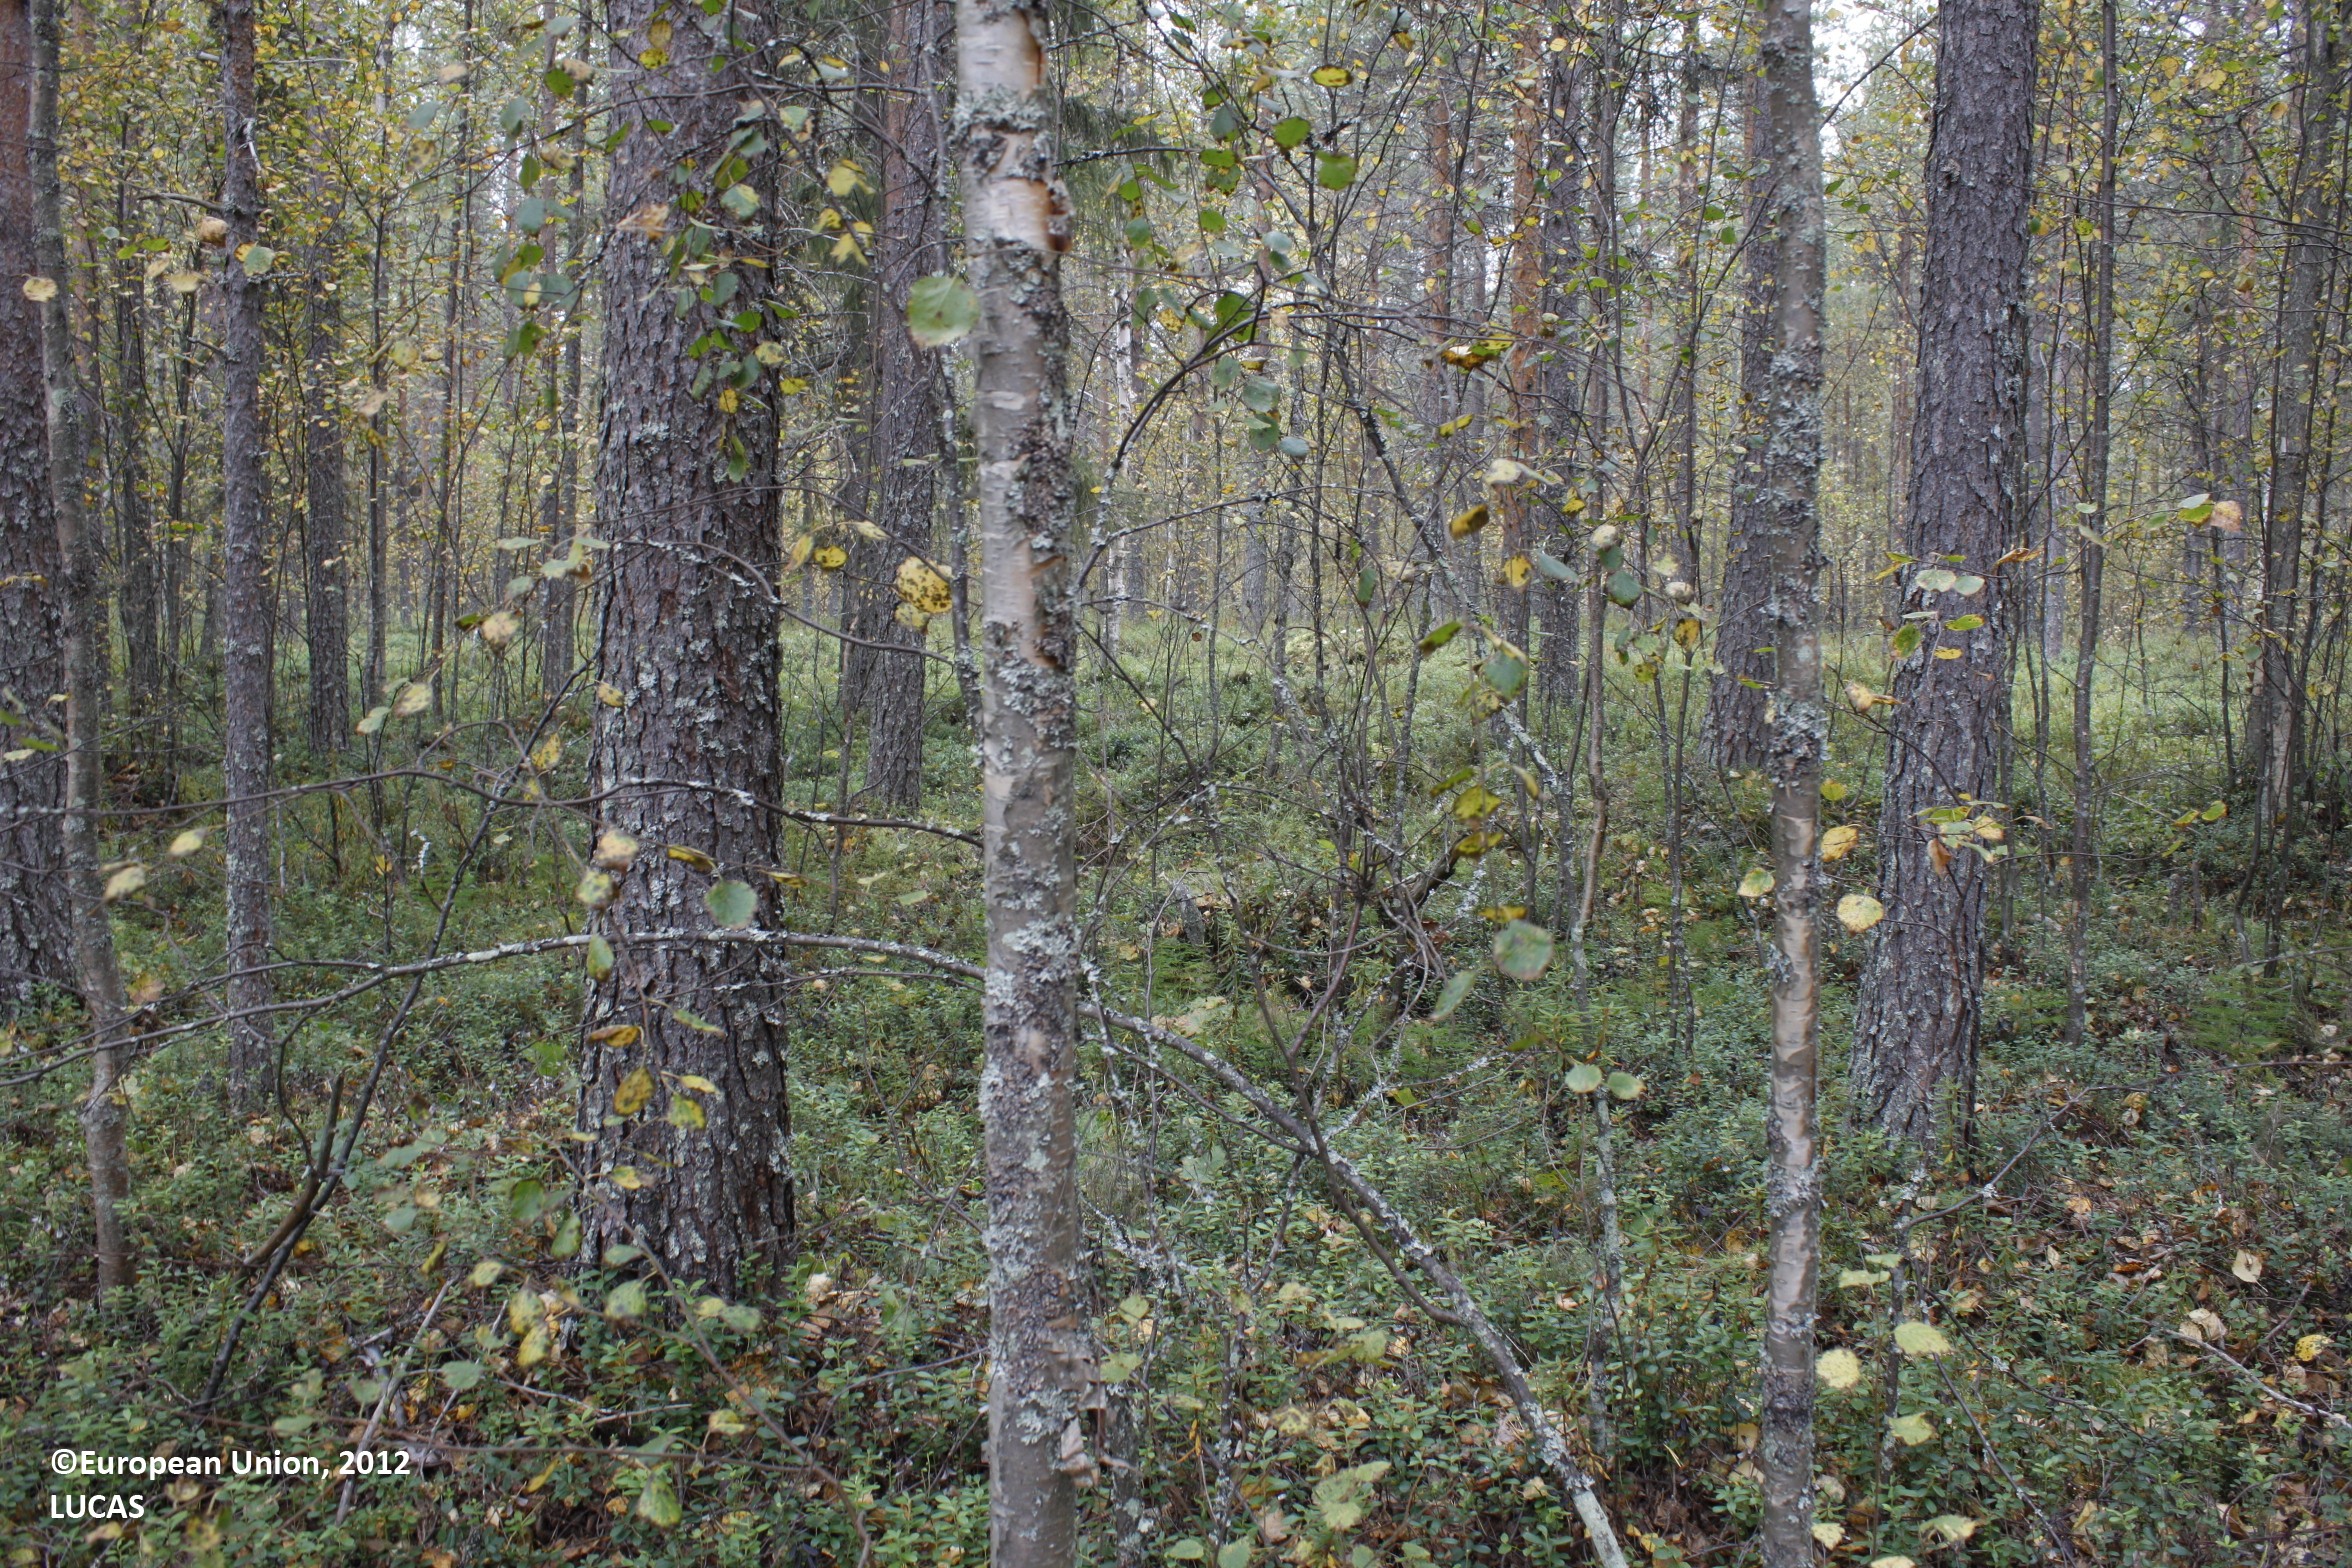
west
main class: Woodland
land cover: Pine dominated mixed woodland
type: boreal forest
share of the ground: > 75 %
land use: Forestry
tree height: > 5 m
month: September
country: FI
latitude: 65.3841
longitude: 27.0066
